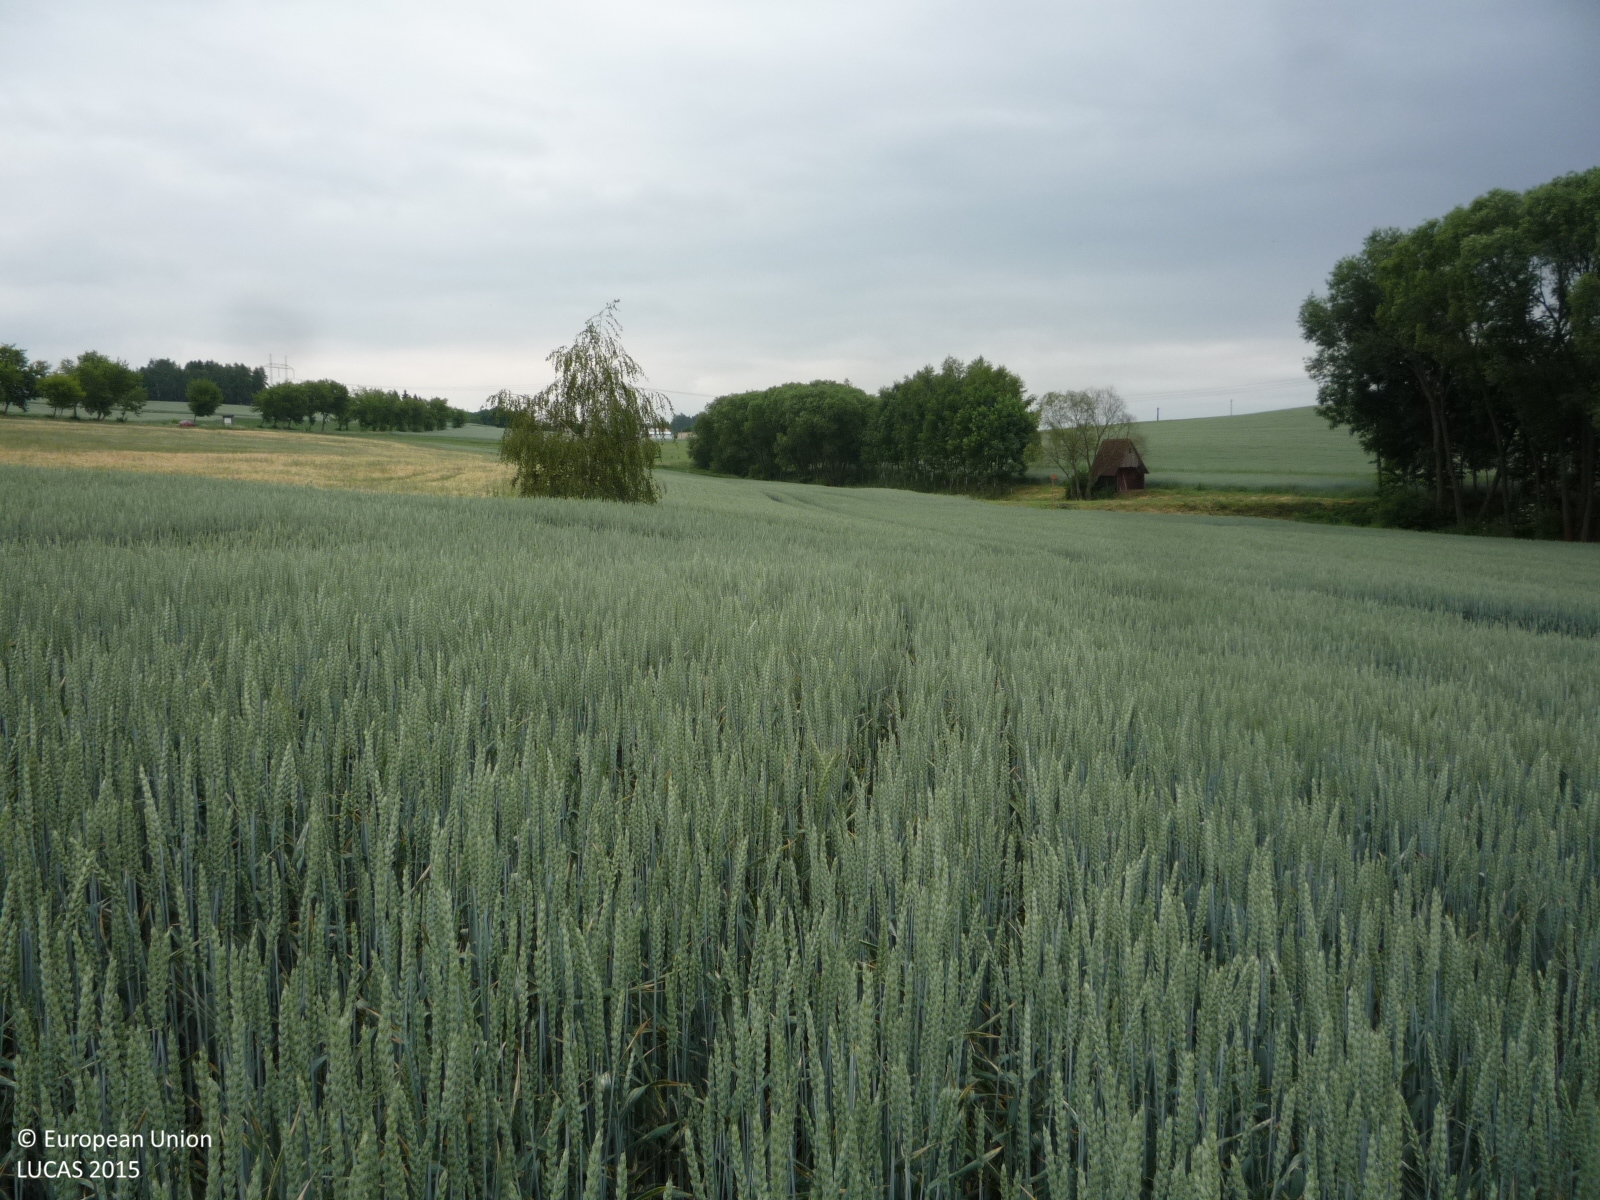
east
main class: Cropland
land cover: Common wheat
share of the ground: > 75 %
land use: Agriculture (excluding fallow land and kitchen gardens)
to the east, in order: Common wheat; Grass margins; Barley
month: June
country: CZ
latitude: 49.8060
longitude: 14.9631
